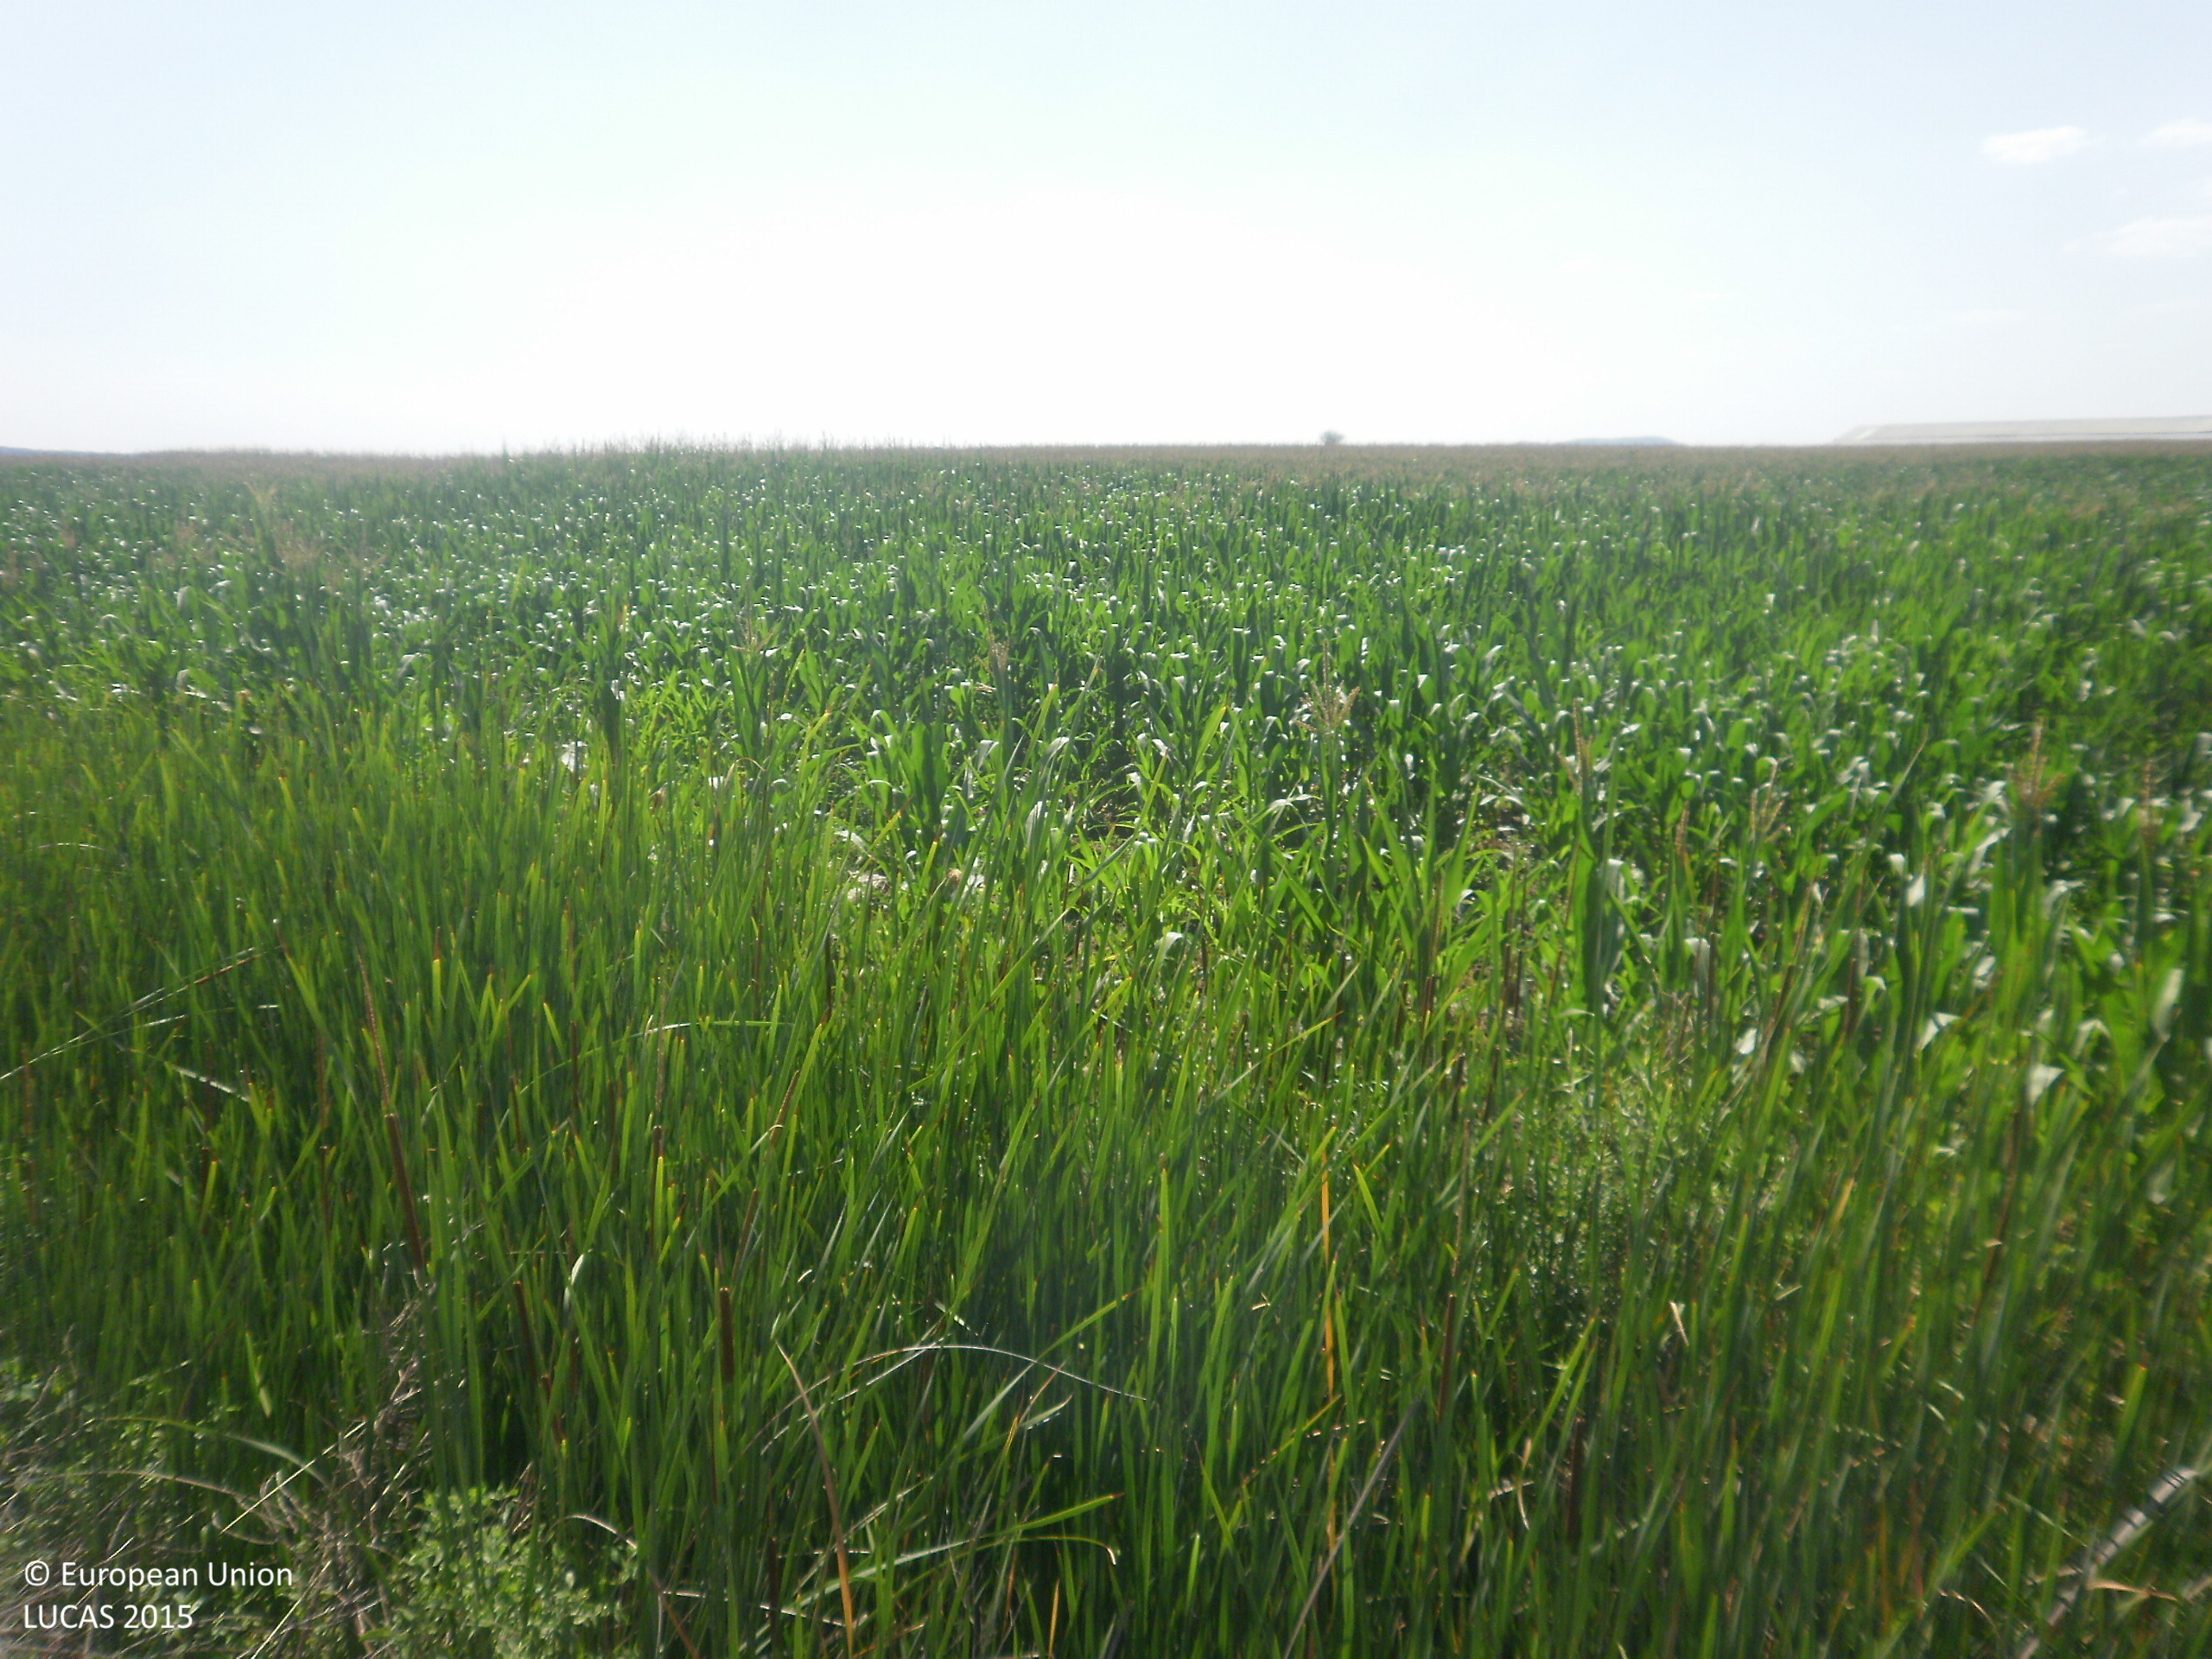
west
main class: Cropland
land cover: Maize
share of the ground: > 75 %
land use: Agriculture (excluding fallow land and kitchen gardens)
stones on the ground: < 10 %
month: June
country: ES
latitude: 39.0569
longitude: -5.9890
